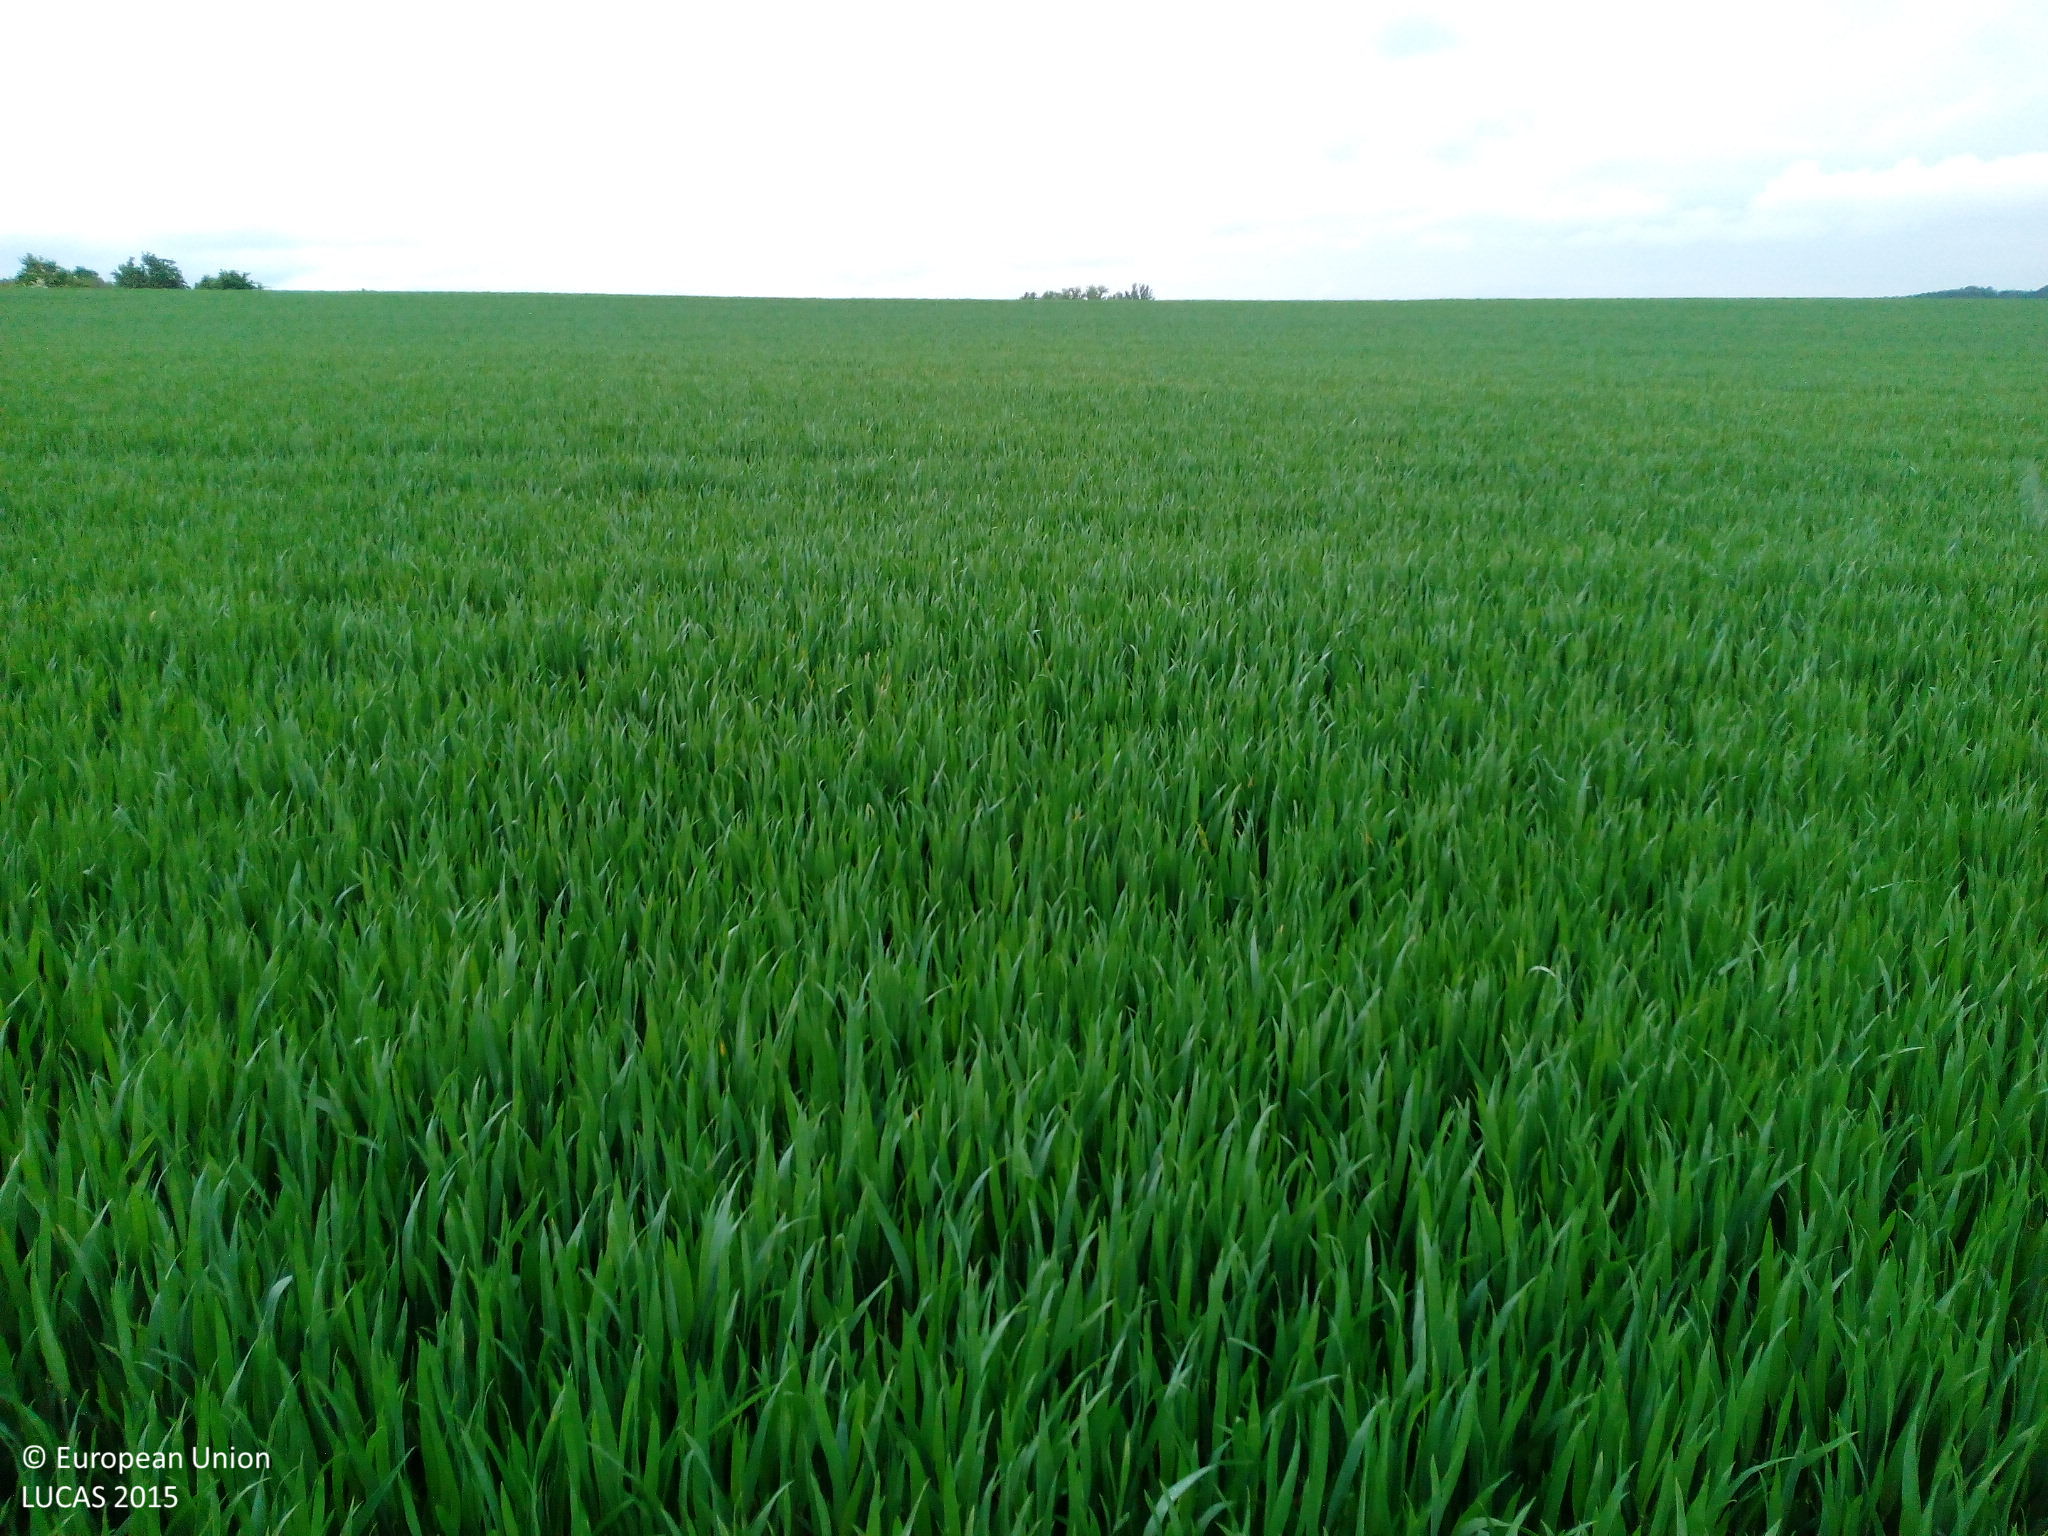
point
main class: Cropland
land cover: Common wheat
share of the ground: > 75 %
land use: Agriculture (excluding fallow land and kitchen gardens)
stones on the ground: < 10 %
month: May
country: DE
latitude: 49.1766
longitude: 10.3154
